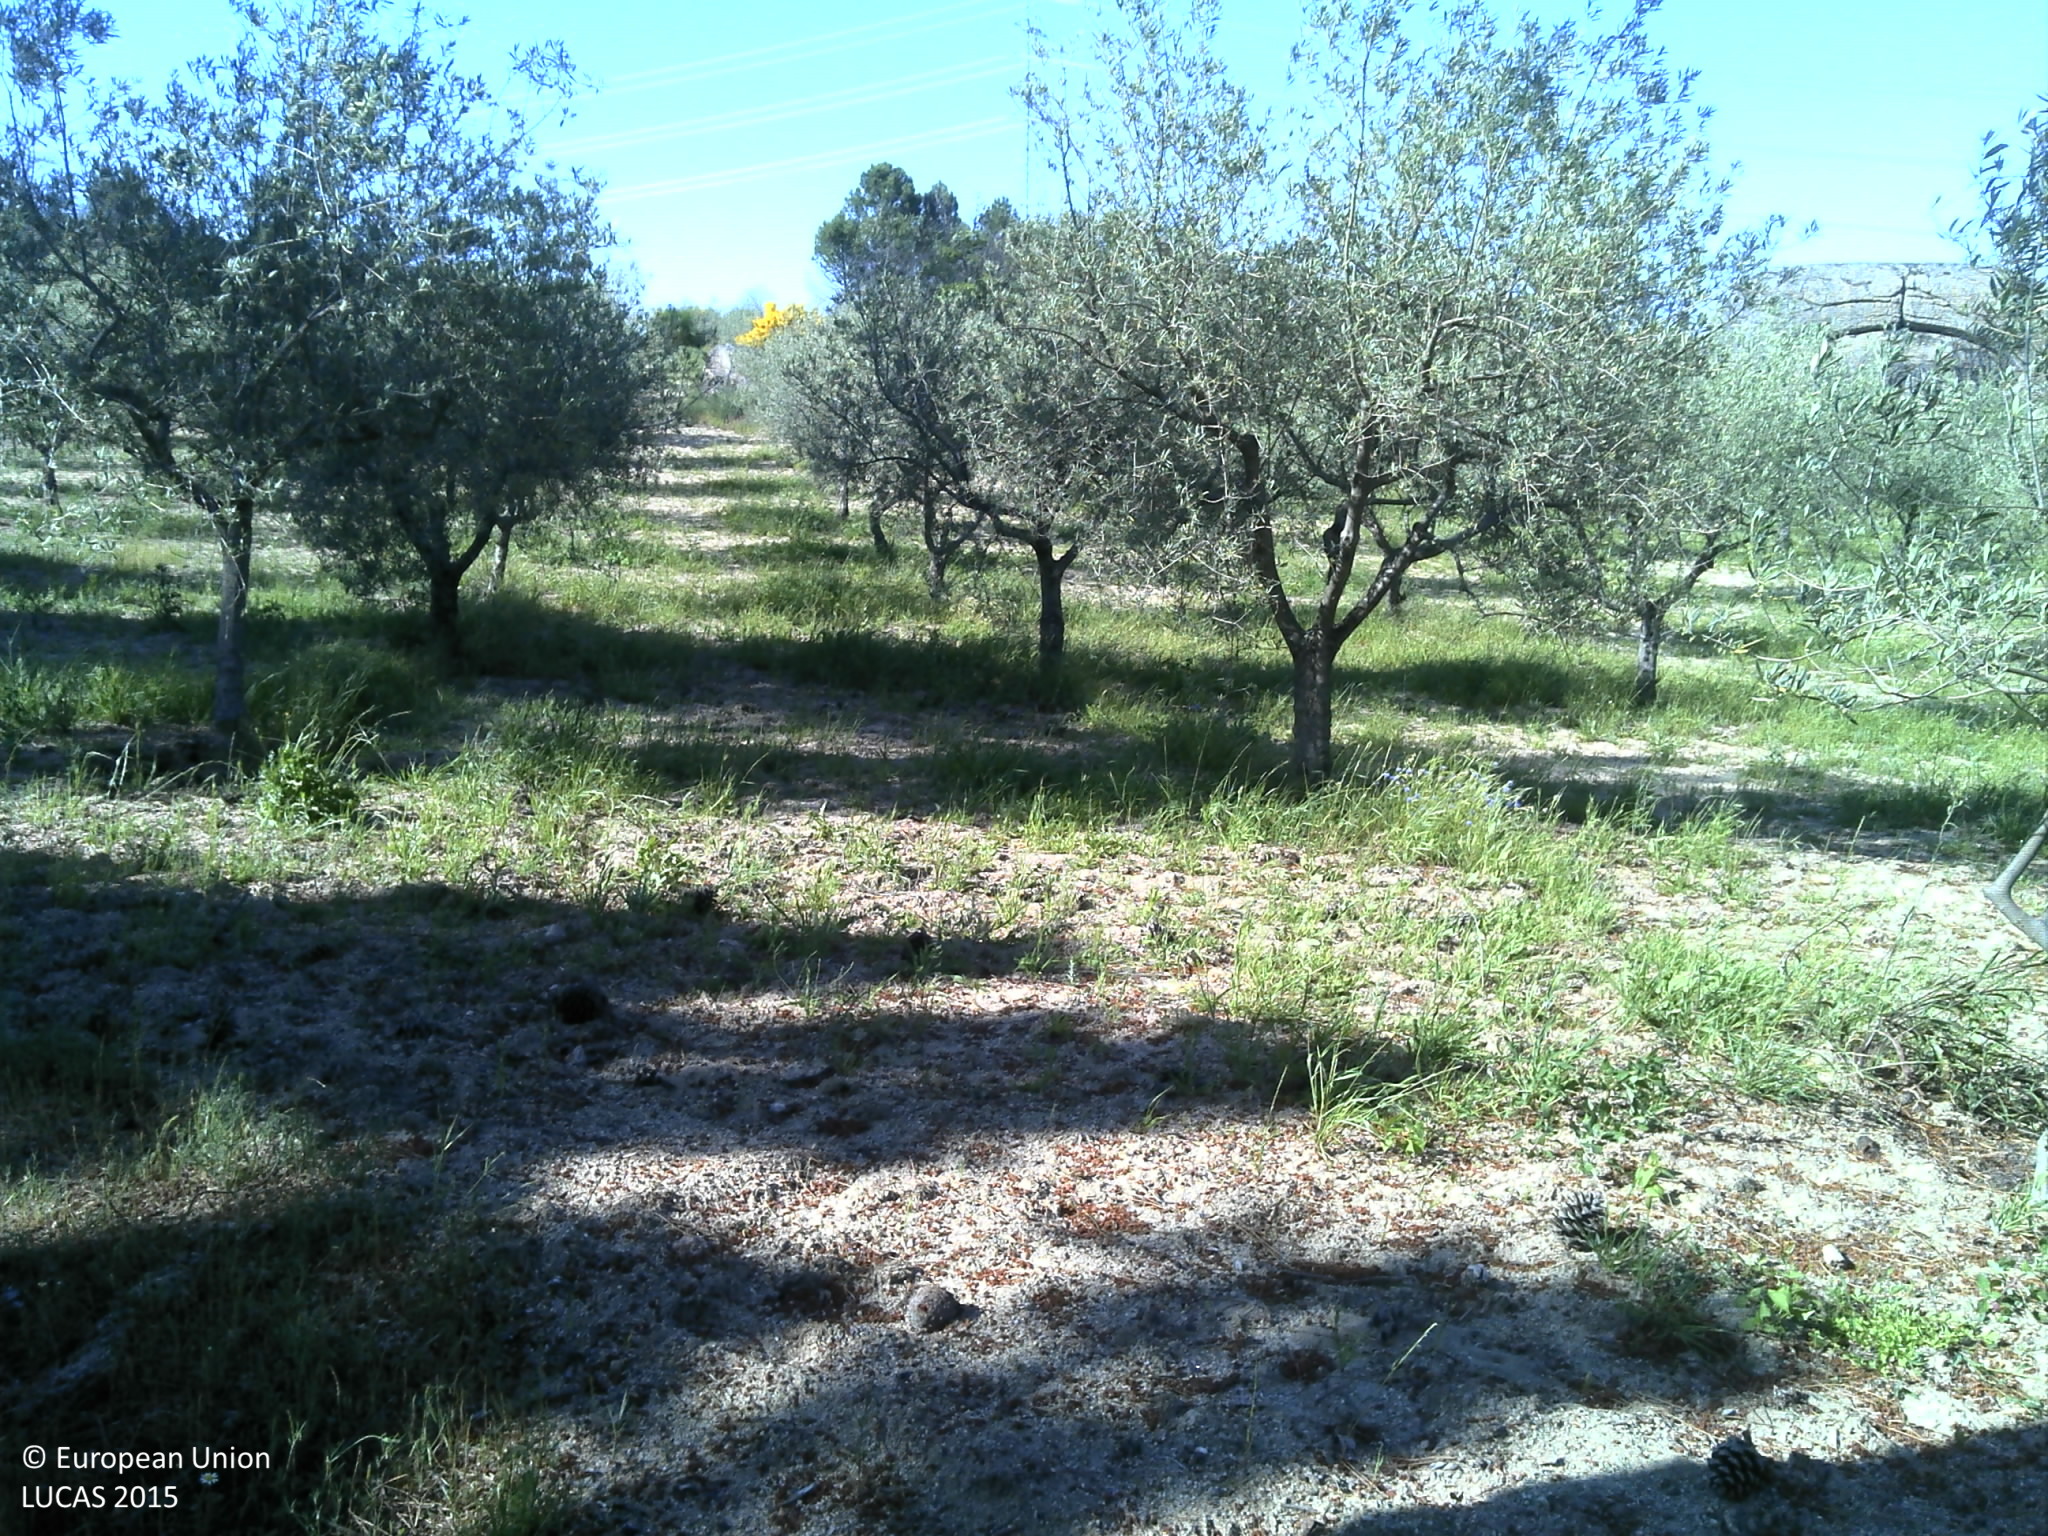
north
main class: Woodland
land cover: Pine dominated mixed woodland
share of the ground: 10 - 25 %
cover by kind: shrubs 50 %, herbaceous plants 15 %, consolidated bare surface 15 %, coniferous forest trees 10 %, broadleaved forest trees 5 %, unconsolidated bare surface 5 %
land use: Forestry
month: May
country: PT
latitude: 41.6443
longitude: -7.3299
